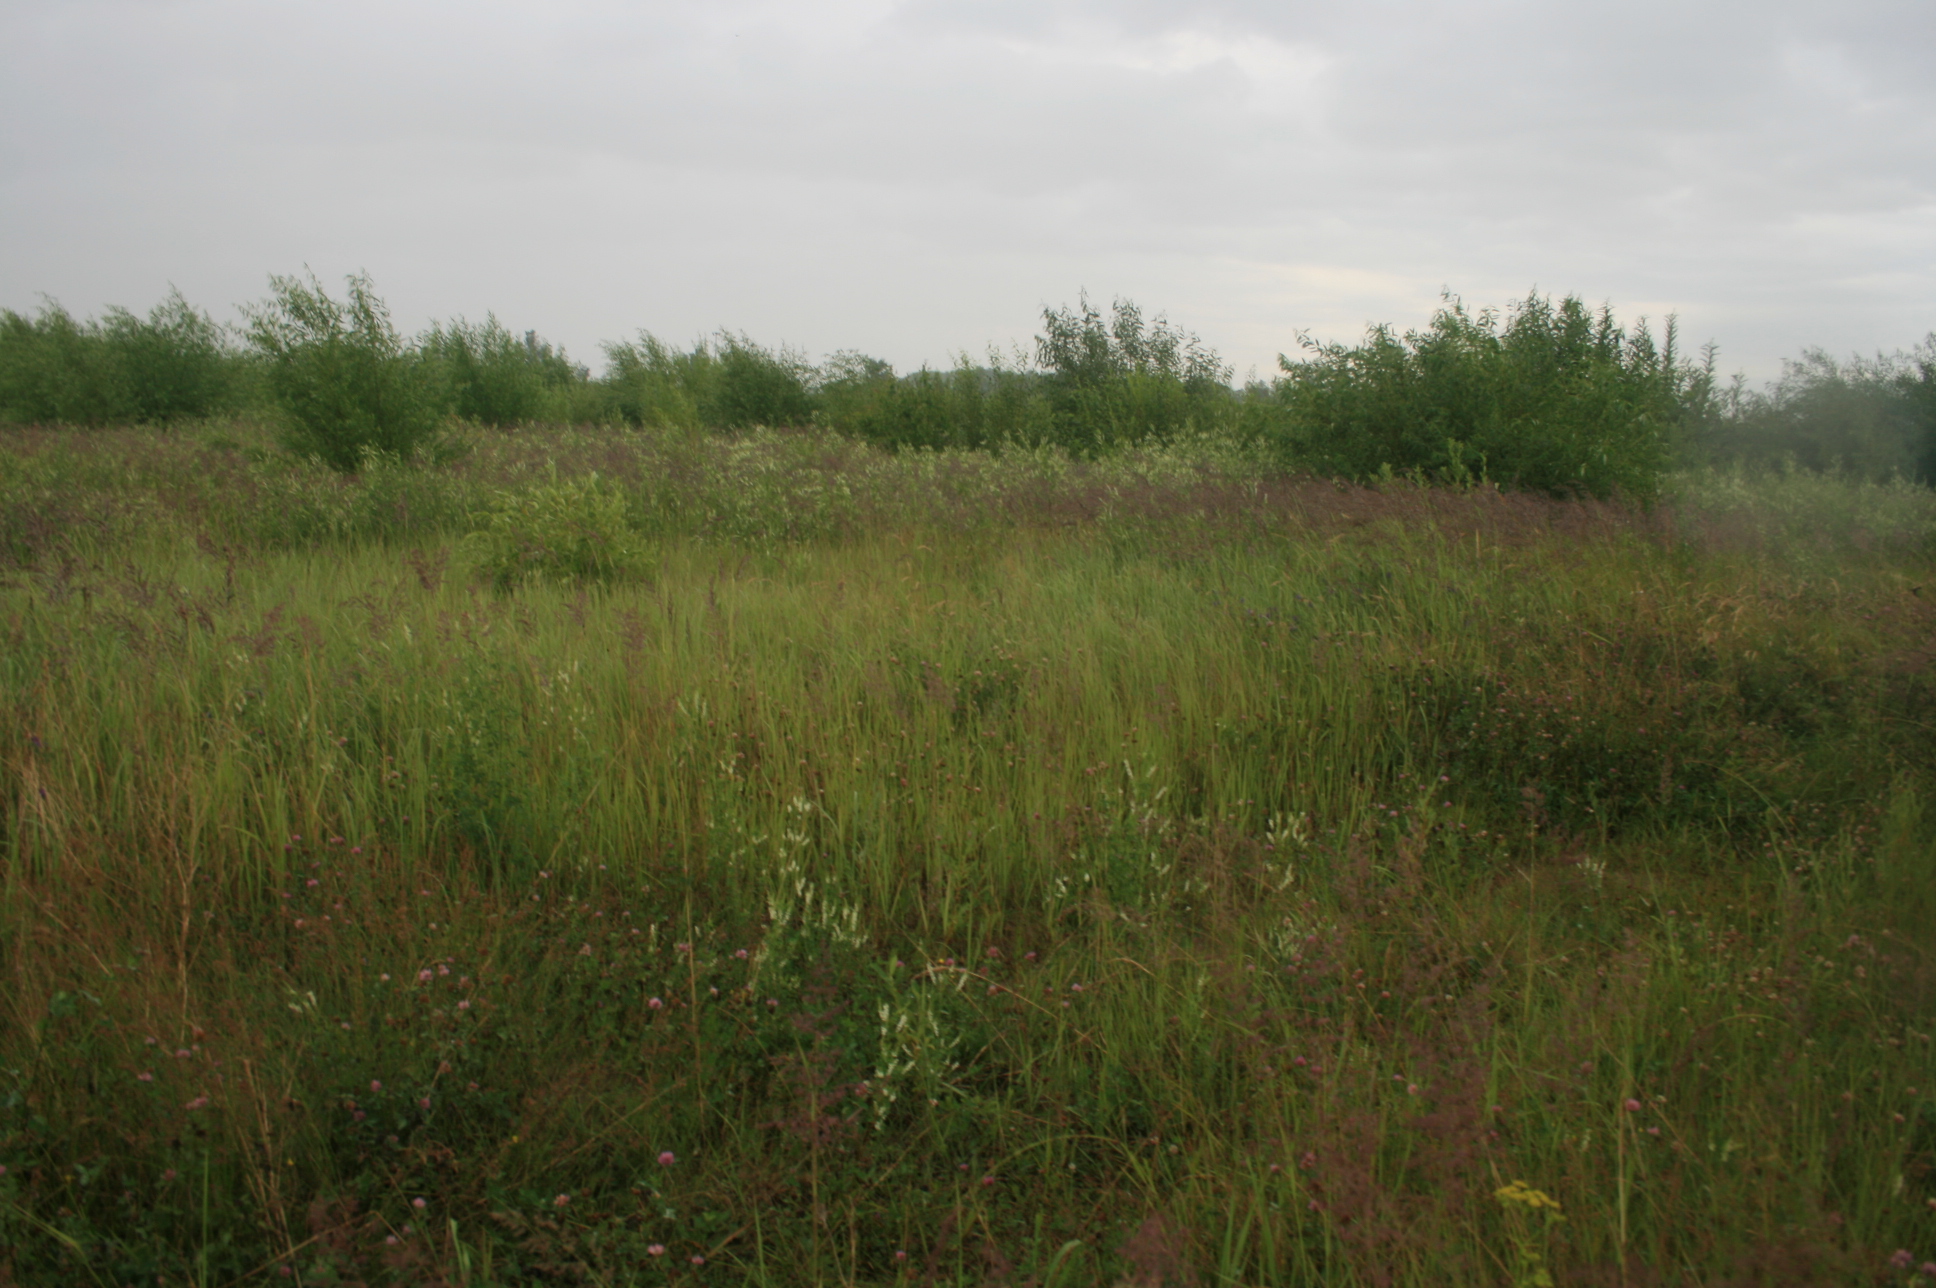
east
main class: Grassland
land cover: Grassland with sparse tree/shrub cover
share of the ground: > 75 %
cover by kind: herbaceous plants 90 %, broadleaved forest trees 5 %, shrubs 5 %
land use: Semi-natural and natural areas not in use
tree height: < 5 m
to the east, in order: Grassland with sparse tree/shrub cover; Broadleaved woodland; Grassland with sparse tree/shrub cover; Broadleaved woodland; Inland marshes; Broadleaved woodland; Grassland with sparse tree/shrub cover
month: July
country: LT
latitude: 55.6581
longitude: 21.2153
